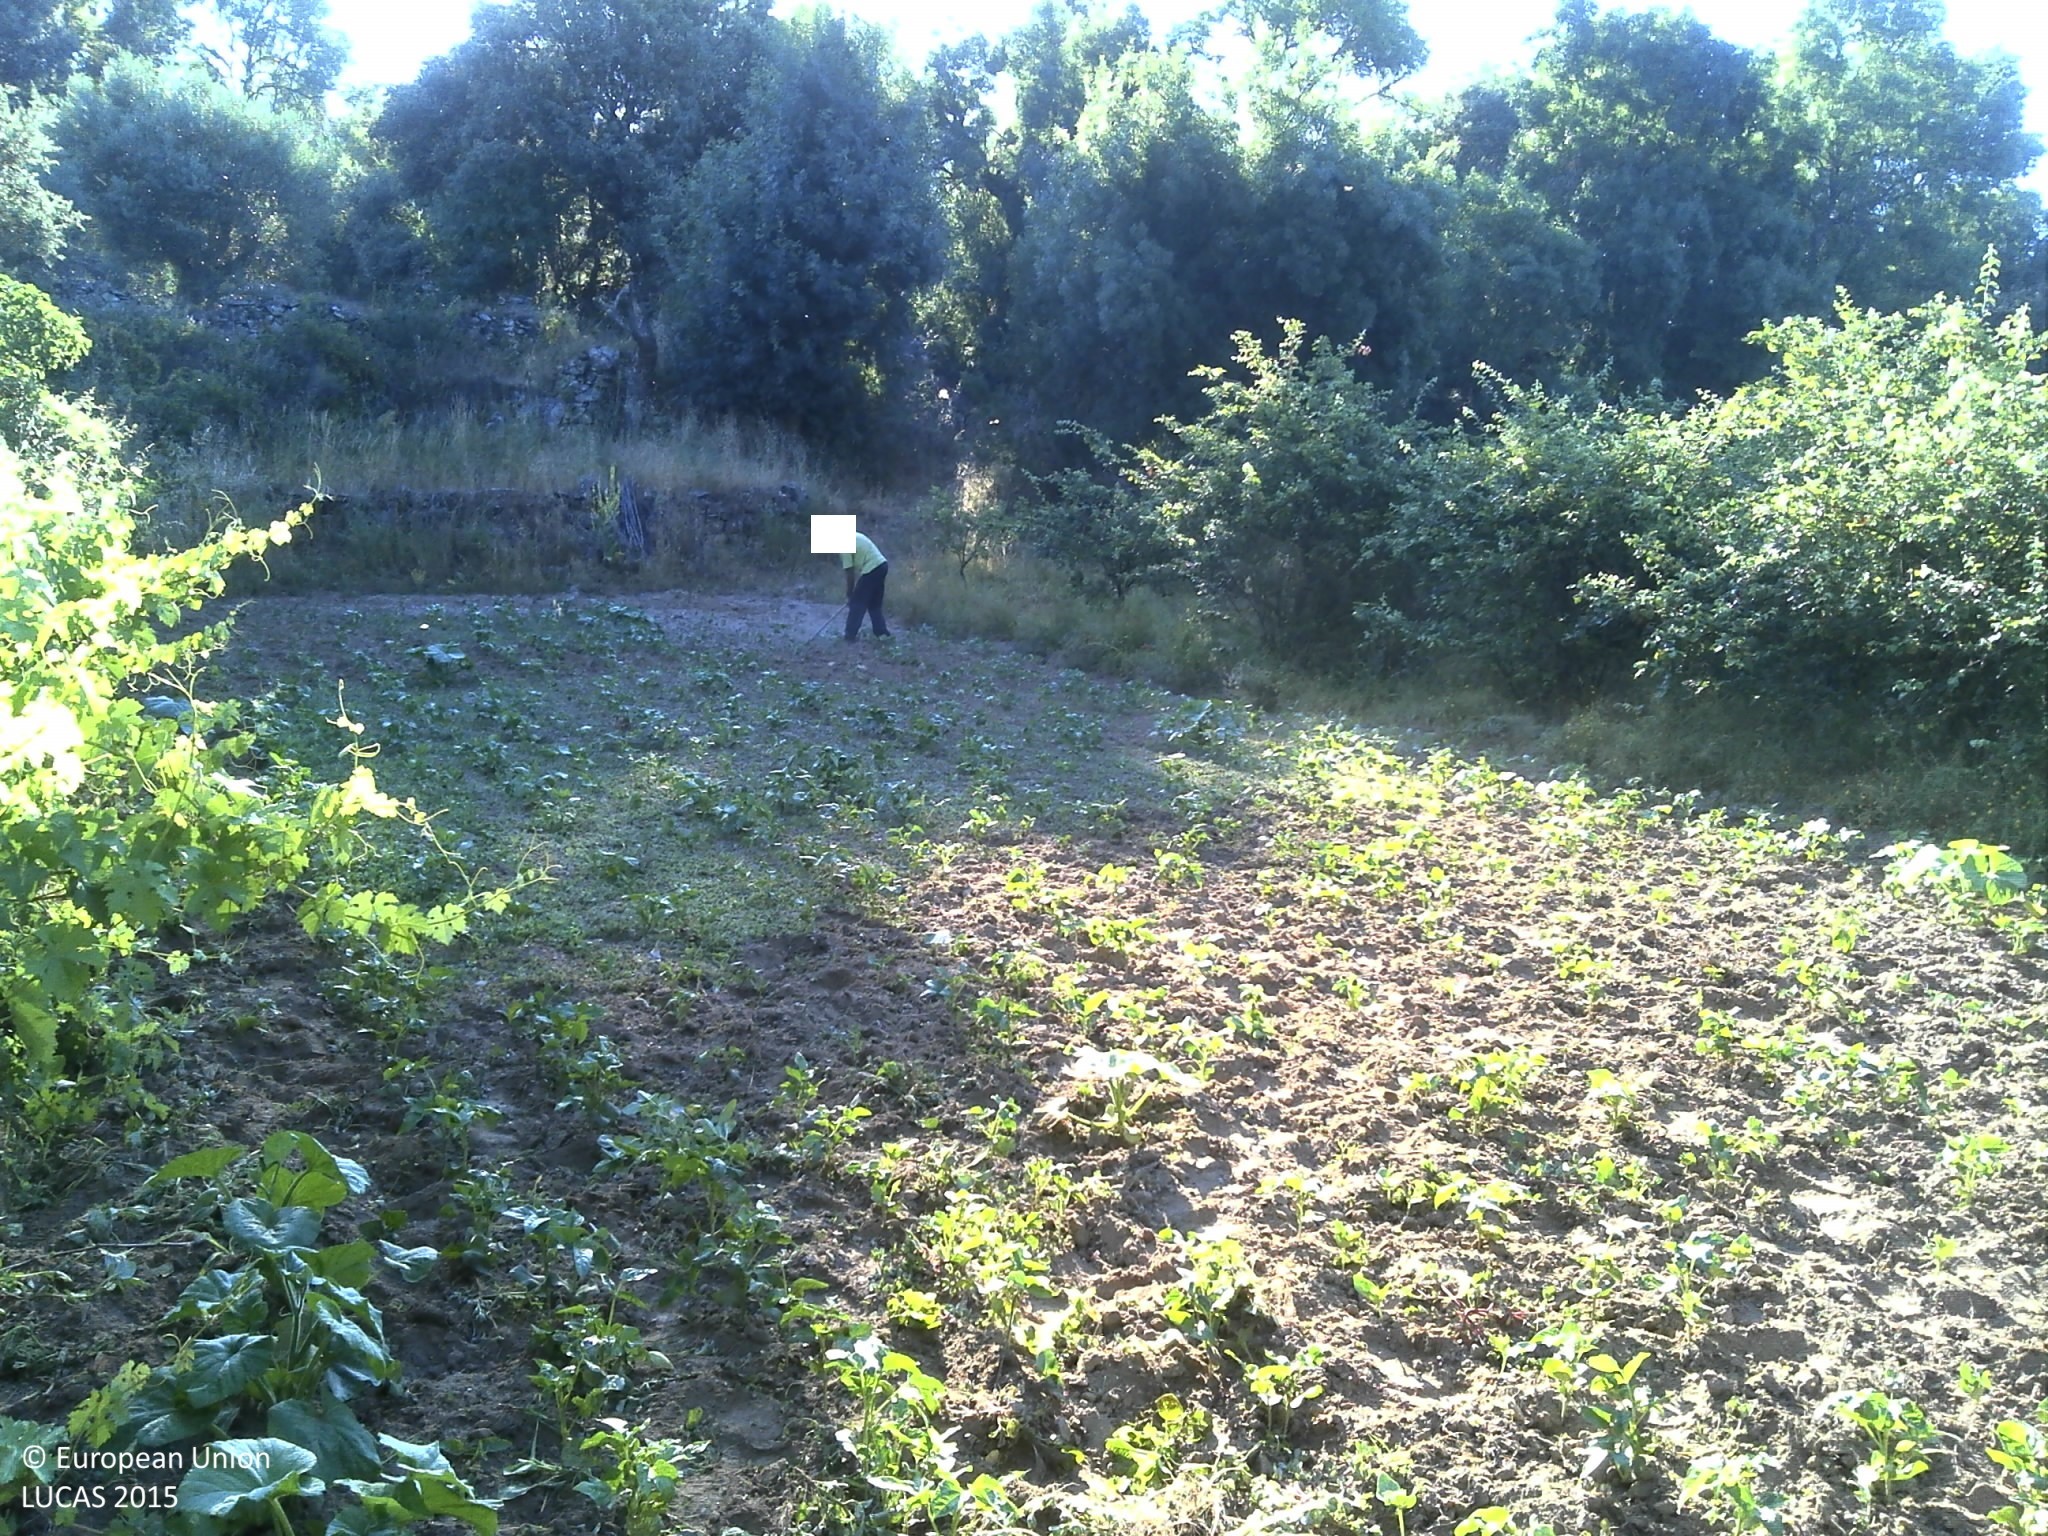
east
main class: Shrubland
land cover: Shrubland without tree cover
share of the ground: > 75 %
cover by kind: shrubs 100 %
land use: Abandoned areas
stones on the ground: < 10 %
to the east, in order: Shrubland without tree cover; Dry stone walls; Other fresh vegetables; Other fruit trees and berries; Broadleaved woodland; Dry stone walls; Broadleaved woodland; Olive groves; Tracks; Dry stone walls; Other fruit trees and berries; Spontaneously vegetated surfaces; Dry stone walls; Spontaneously vegetated surfaces; Ponds and wetlands; Dry stone walls; Tracks; Dry stone walls; Broadleaved woodland; Tracks; Dry stone walls; Abandoned hedges
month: June
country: PT
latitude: 40.8030
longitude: -7.1888
